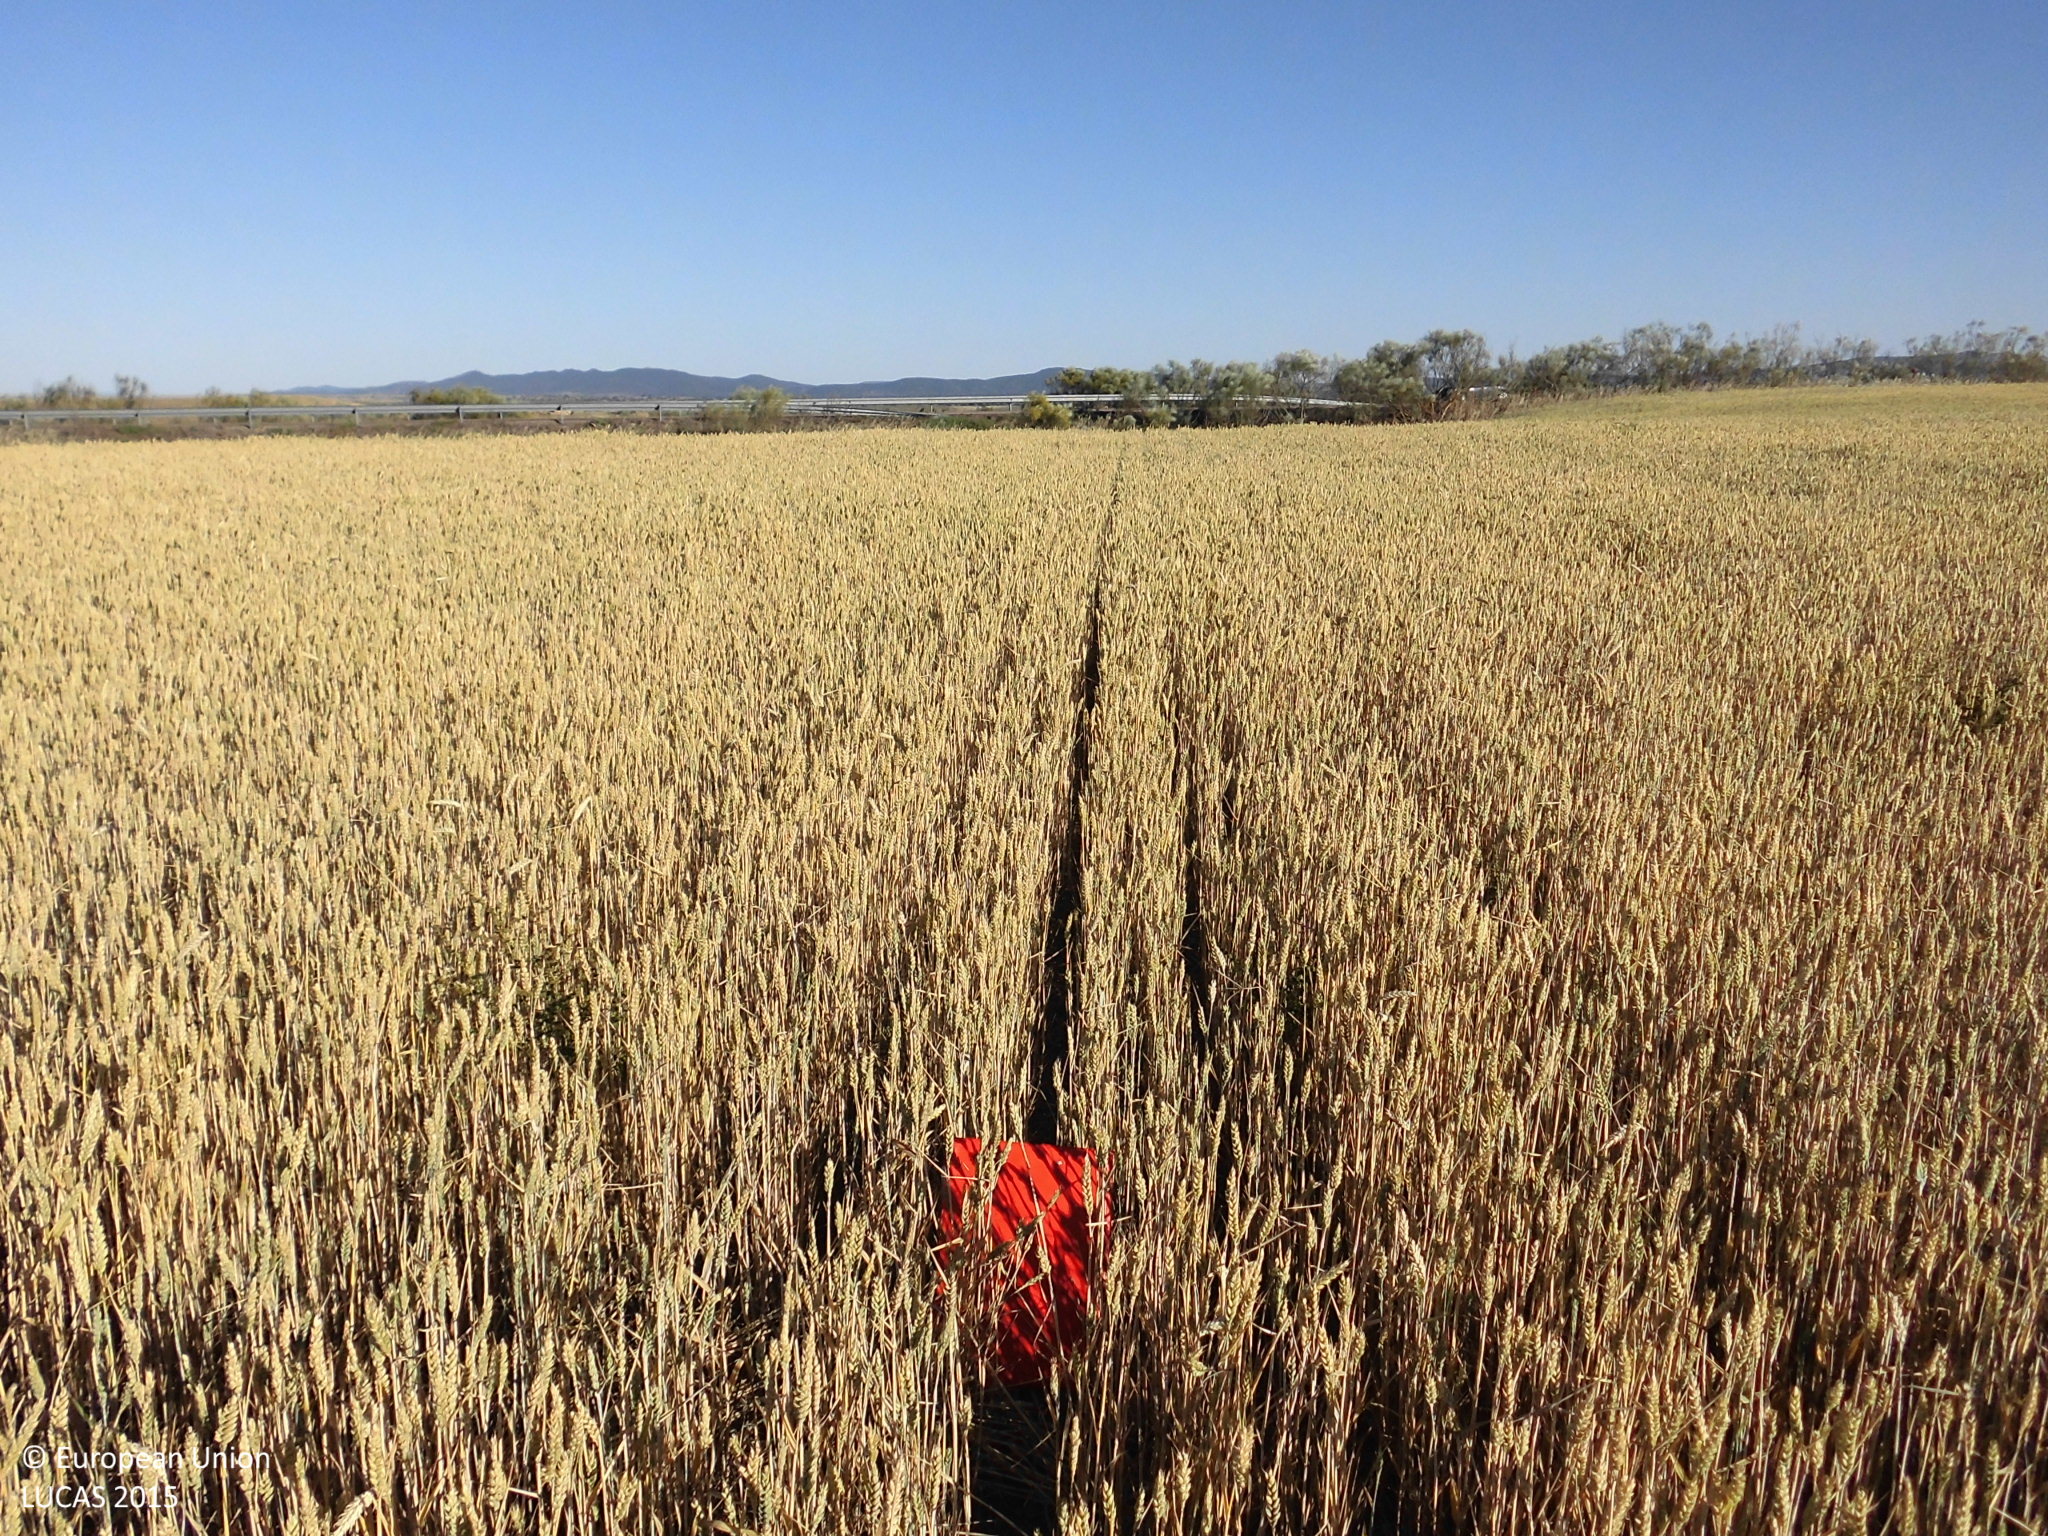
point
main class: Cropland
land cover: Common wheat
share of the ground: > 75 %
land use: Agriculture (excluding fallow land and kitchen gardens)
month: May
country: ES
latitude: 39.5148
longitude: -6.8631
